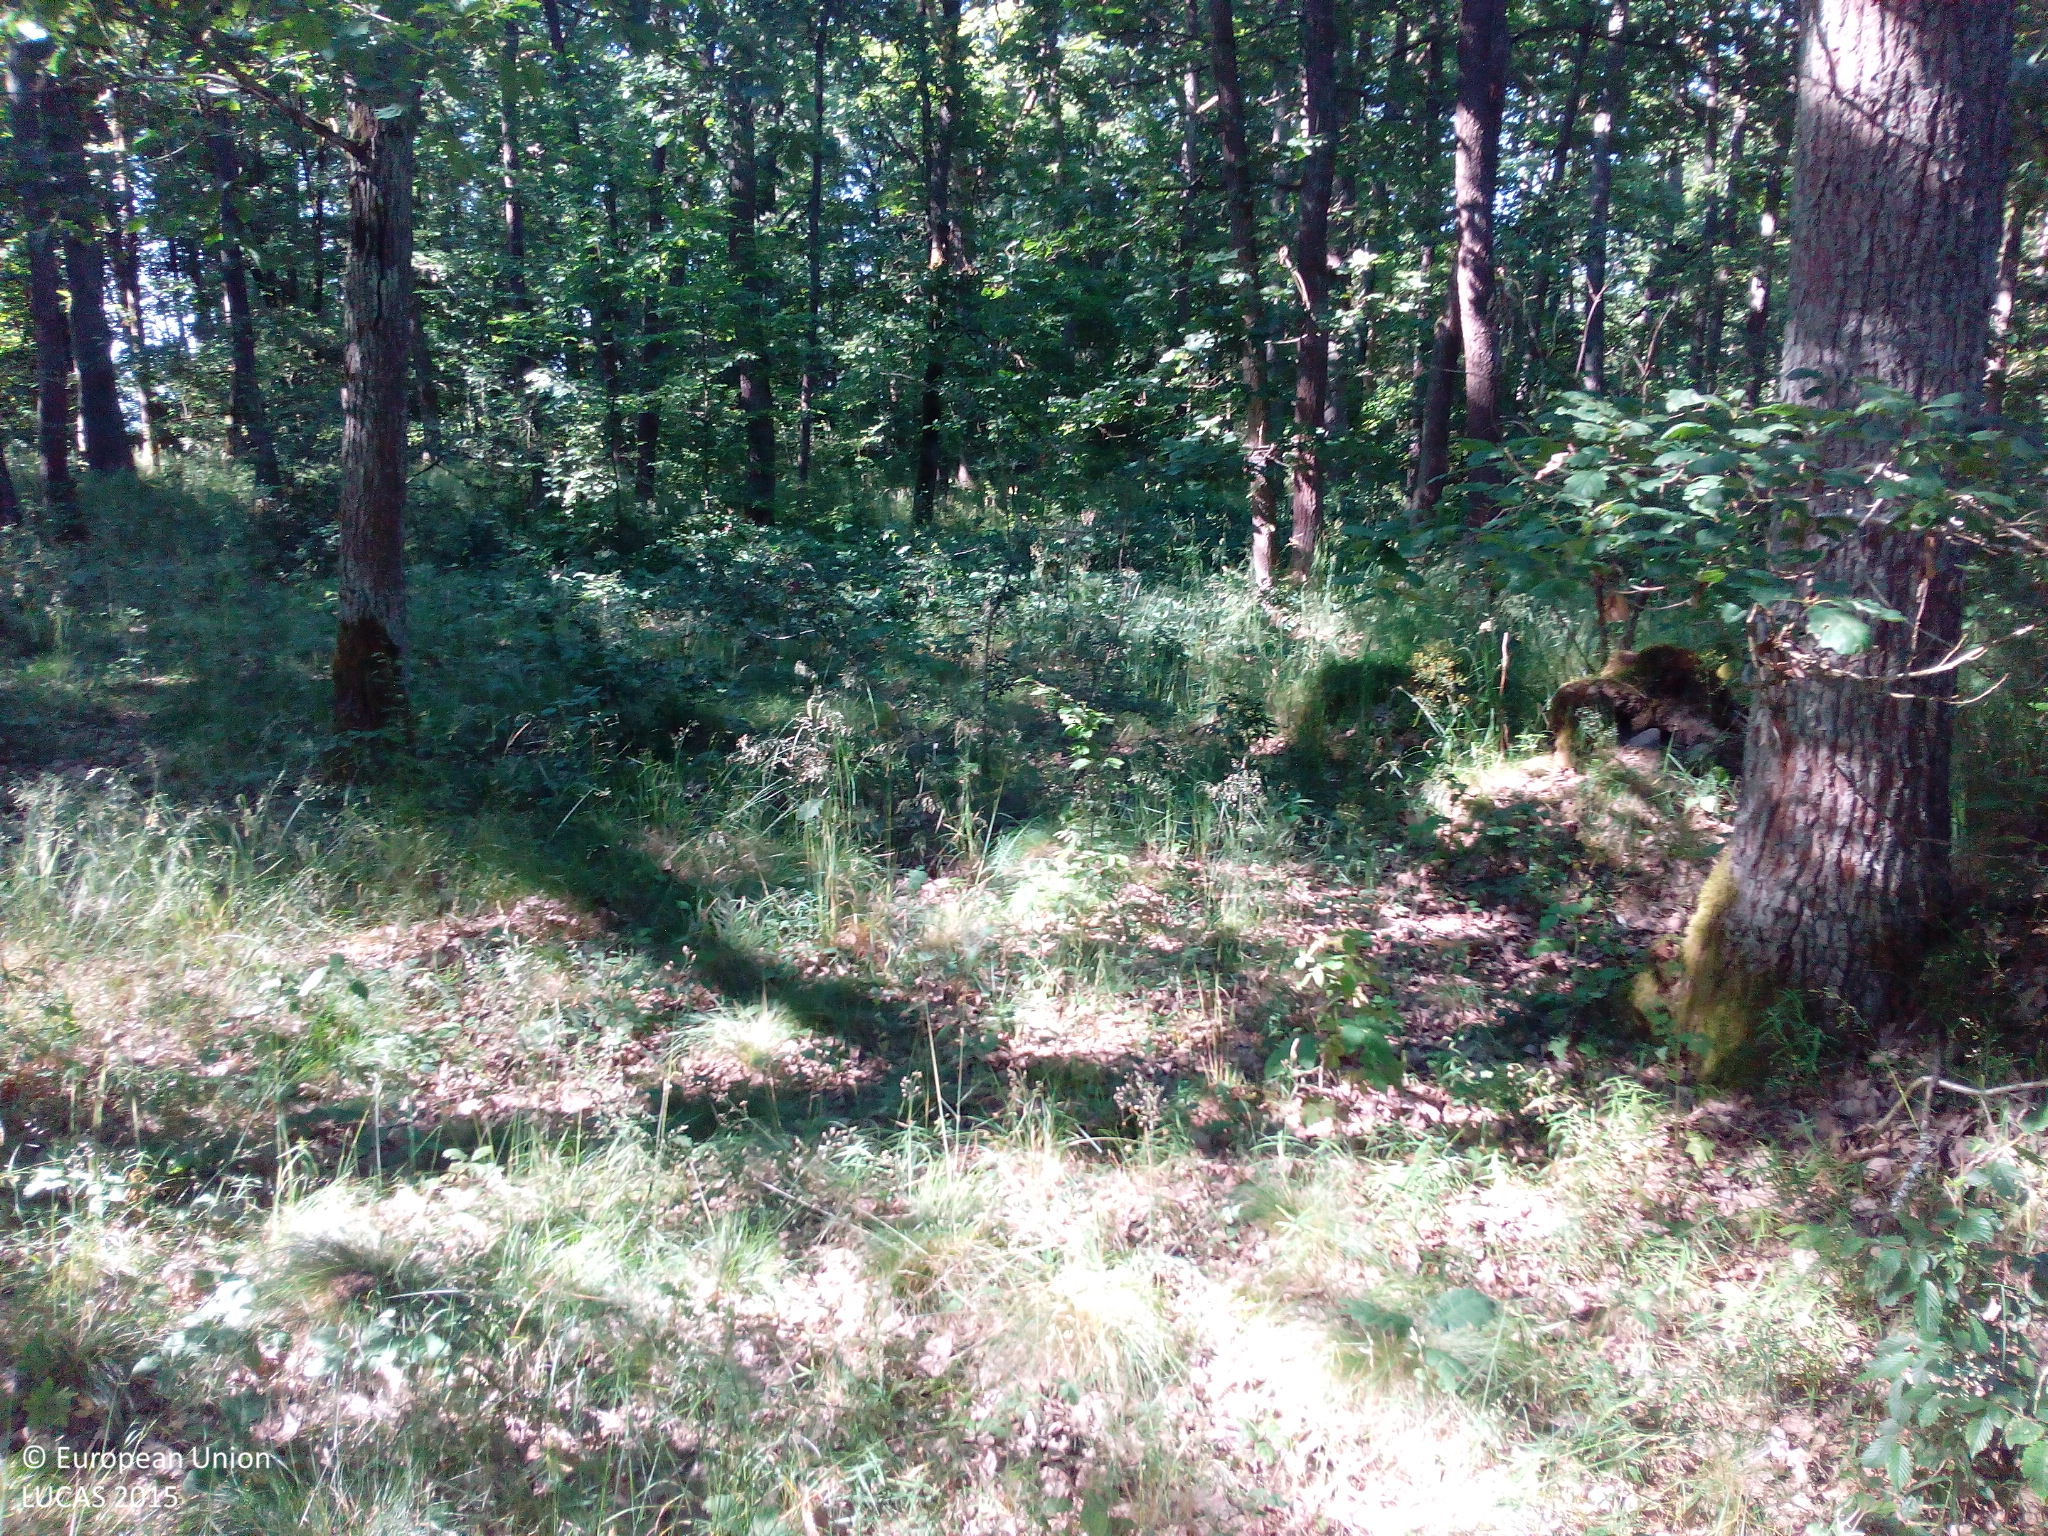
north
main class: Woodland
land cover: Broadleaved woodland
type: mesophytic deciduous forest
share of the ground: > 75 %
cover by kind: broadleaved forest trees 85 %, herbaceous plants 15 %
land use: Forestry
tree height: > 5 m
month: July
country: DE
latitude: 50.3443
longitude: 10.6321
